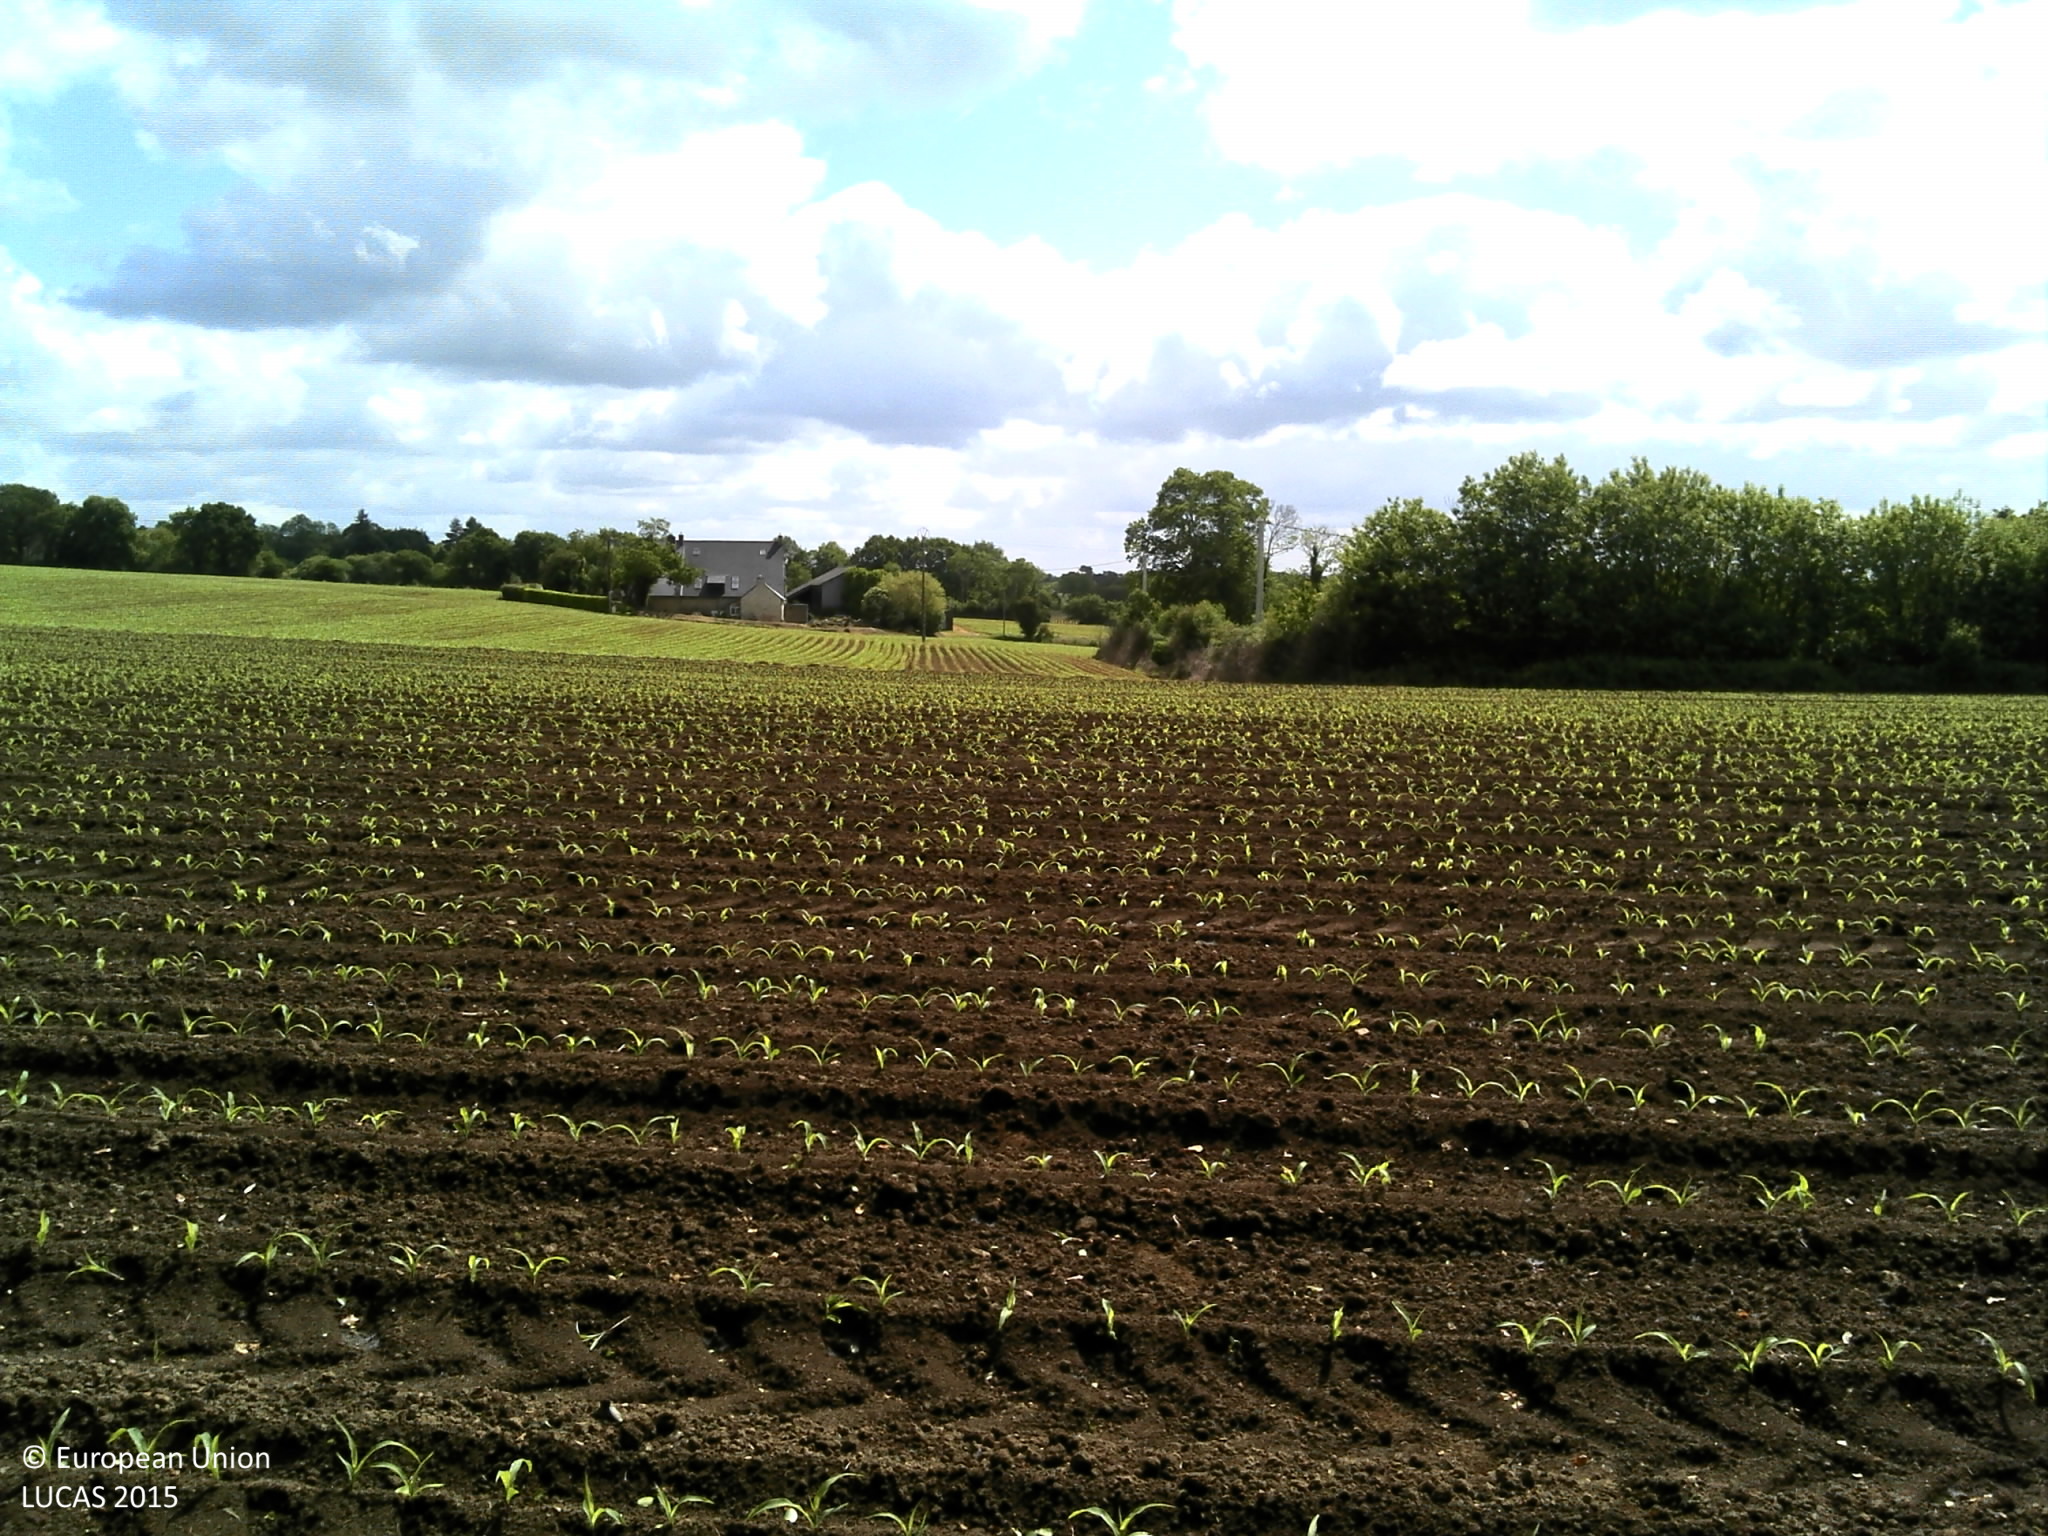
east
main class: Cropland
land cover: Maize
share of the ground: 10 - 25 %
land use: Agriculture (excluding fallow land and kitchen gardens)
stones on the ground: < 10 %
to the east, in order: Maize; Managed hedges; Grassland without tree/shrub cover; Managed hedges; Electric lines; Grassland without tree/shrub cover; Managed hedges; Maize; Electric lines; Maize
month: June
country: FR
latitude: 47.9145
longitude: -3.5240
